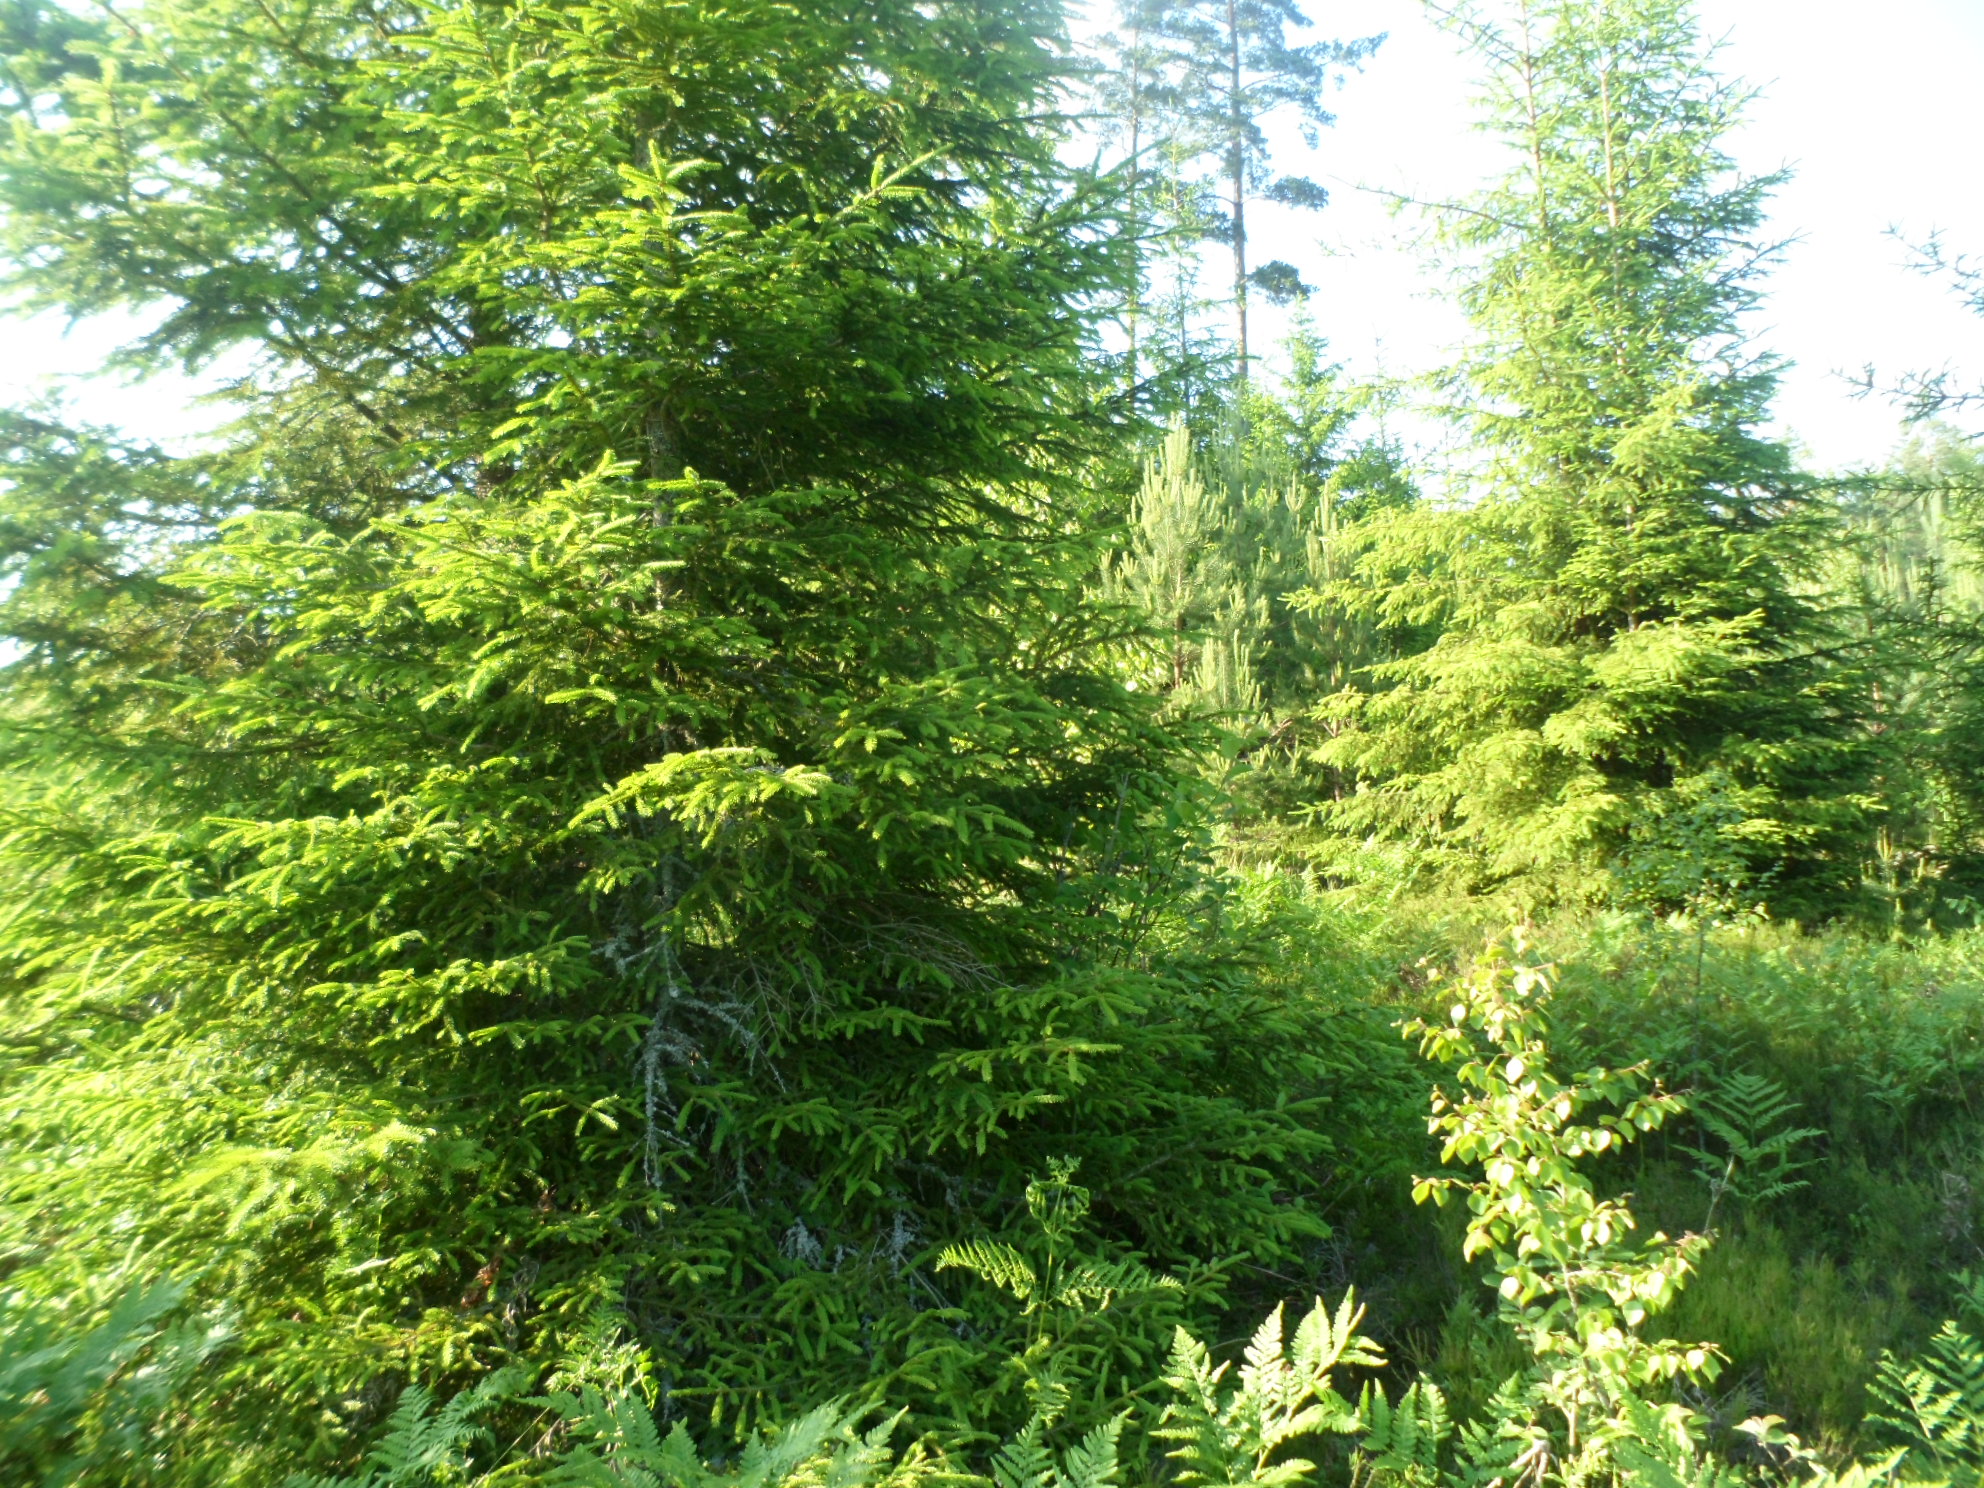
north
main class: Woodland
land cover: Spruce dominated mixed woodland
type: boreal forest
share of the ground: 50 - 75 %
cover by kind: broadleaved forest trees 35 %, coniferous forest trees 30 %, shrubs 15 %, herbaceous plants 10 %, lichens and mosses 10 %
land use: Forestry
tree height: > 5 m
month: June
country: SE
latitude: 57.0990
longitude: 15.4613
